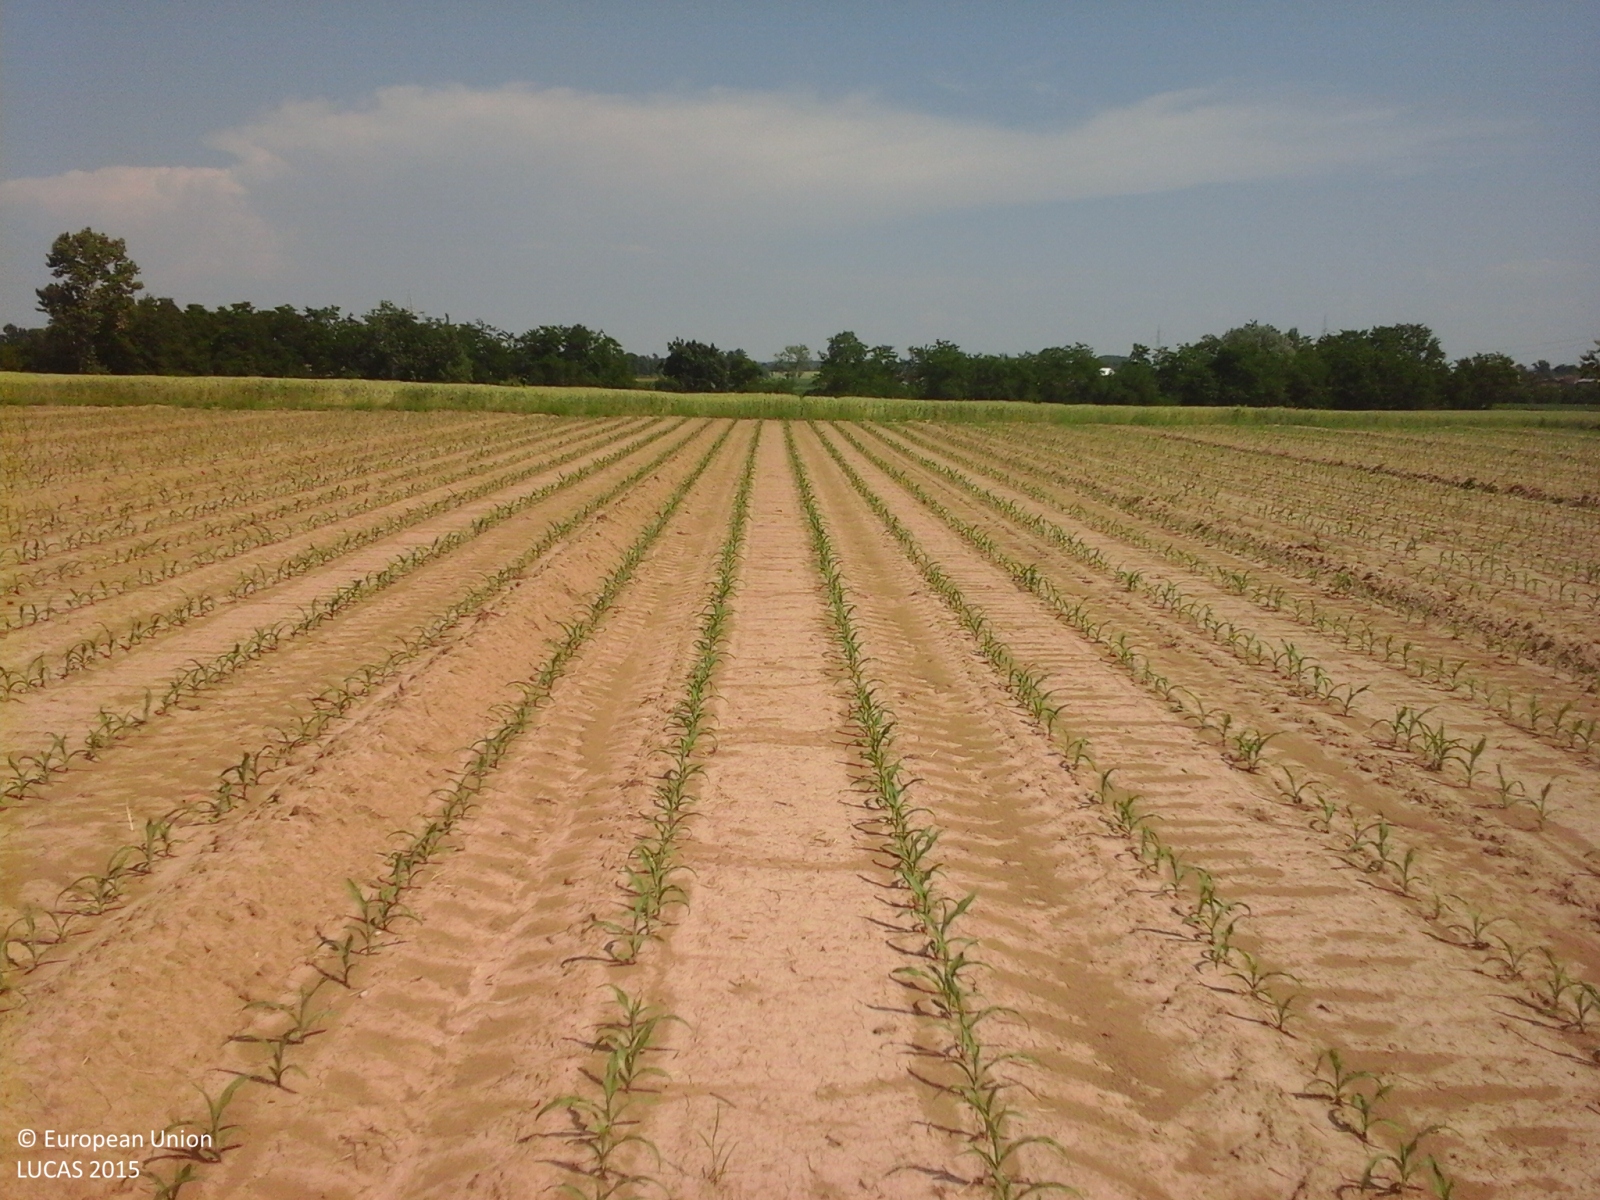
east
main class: Cropland
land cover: Maize
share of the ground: < 10 %
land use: Agriculture (excluding fallow land and kitchen gardens)
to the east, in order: Maize; Tracks; Common wheat; Broadleaved woodland; Inland fresh running water; Electric lines; Broadleaved woodland
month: June
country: IT
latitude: 44.8682
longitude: 7.7892
